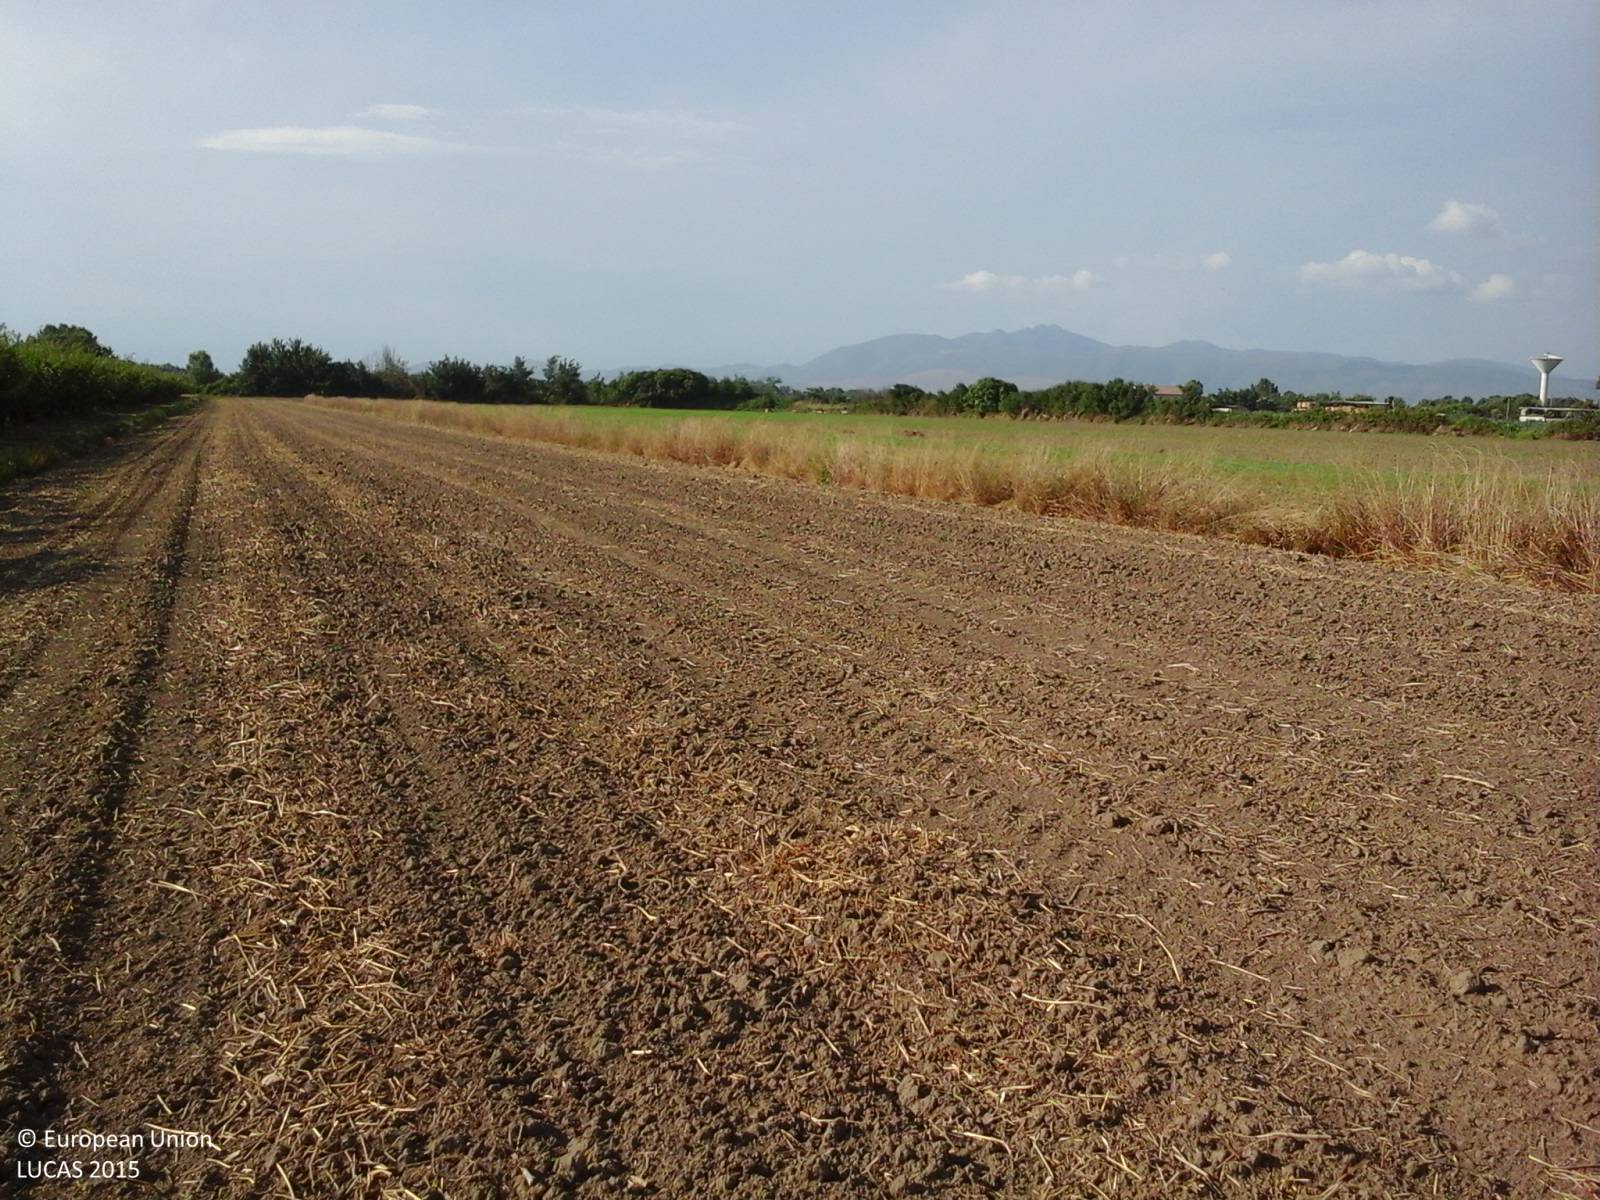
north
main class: Cropland
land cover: Temporary grasslands
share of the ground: < 10 %
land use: Agriculture (excluding fallow land and kitchen gardens)
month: June
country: IT
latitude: 41.0858
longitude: 14.1378
